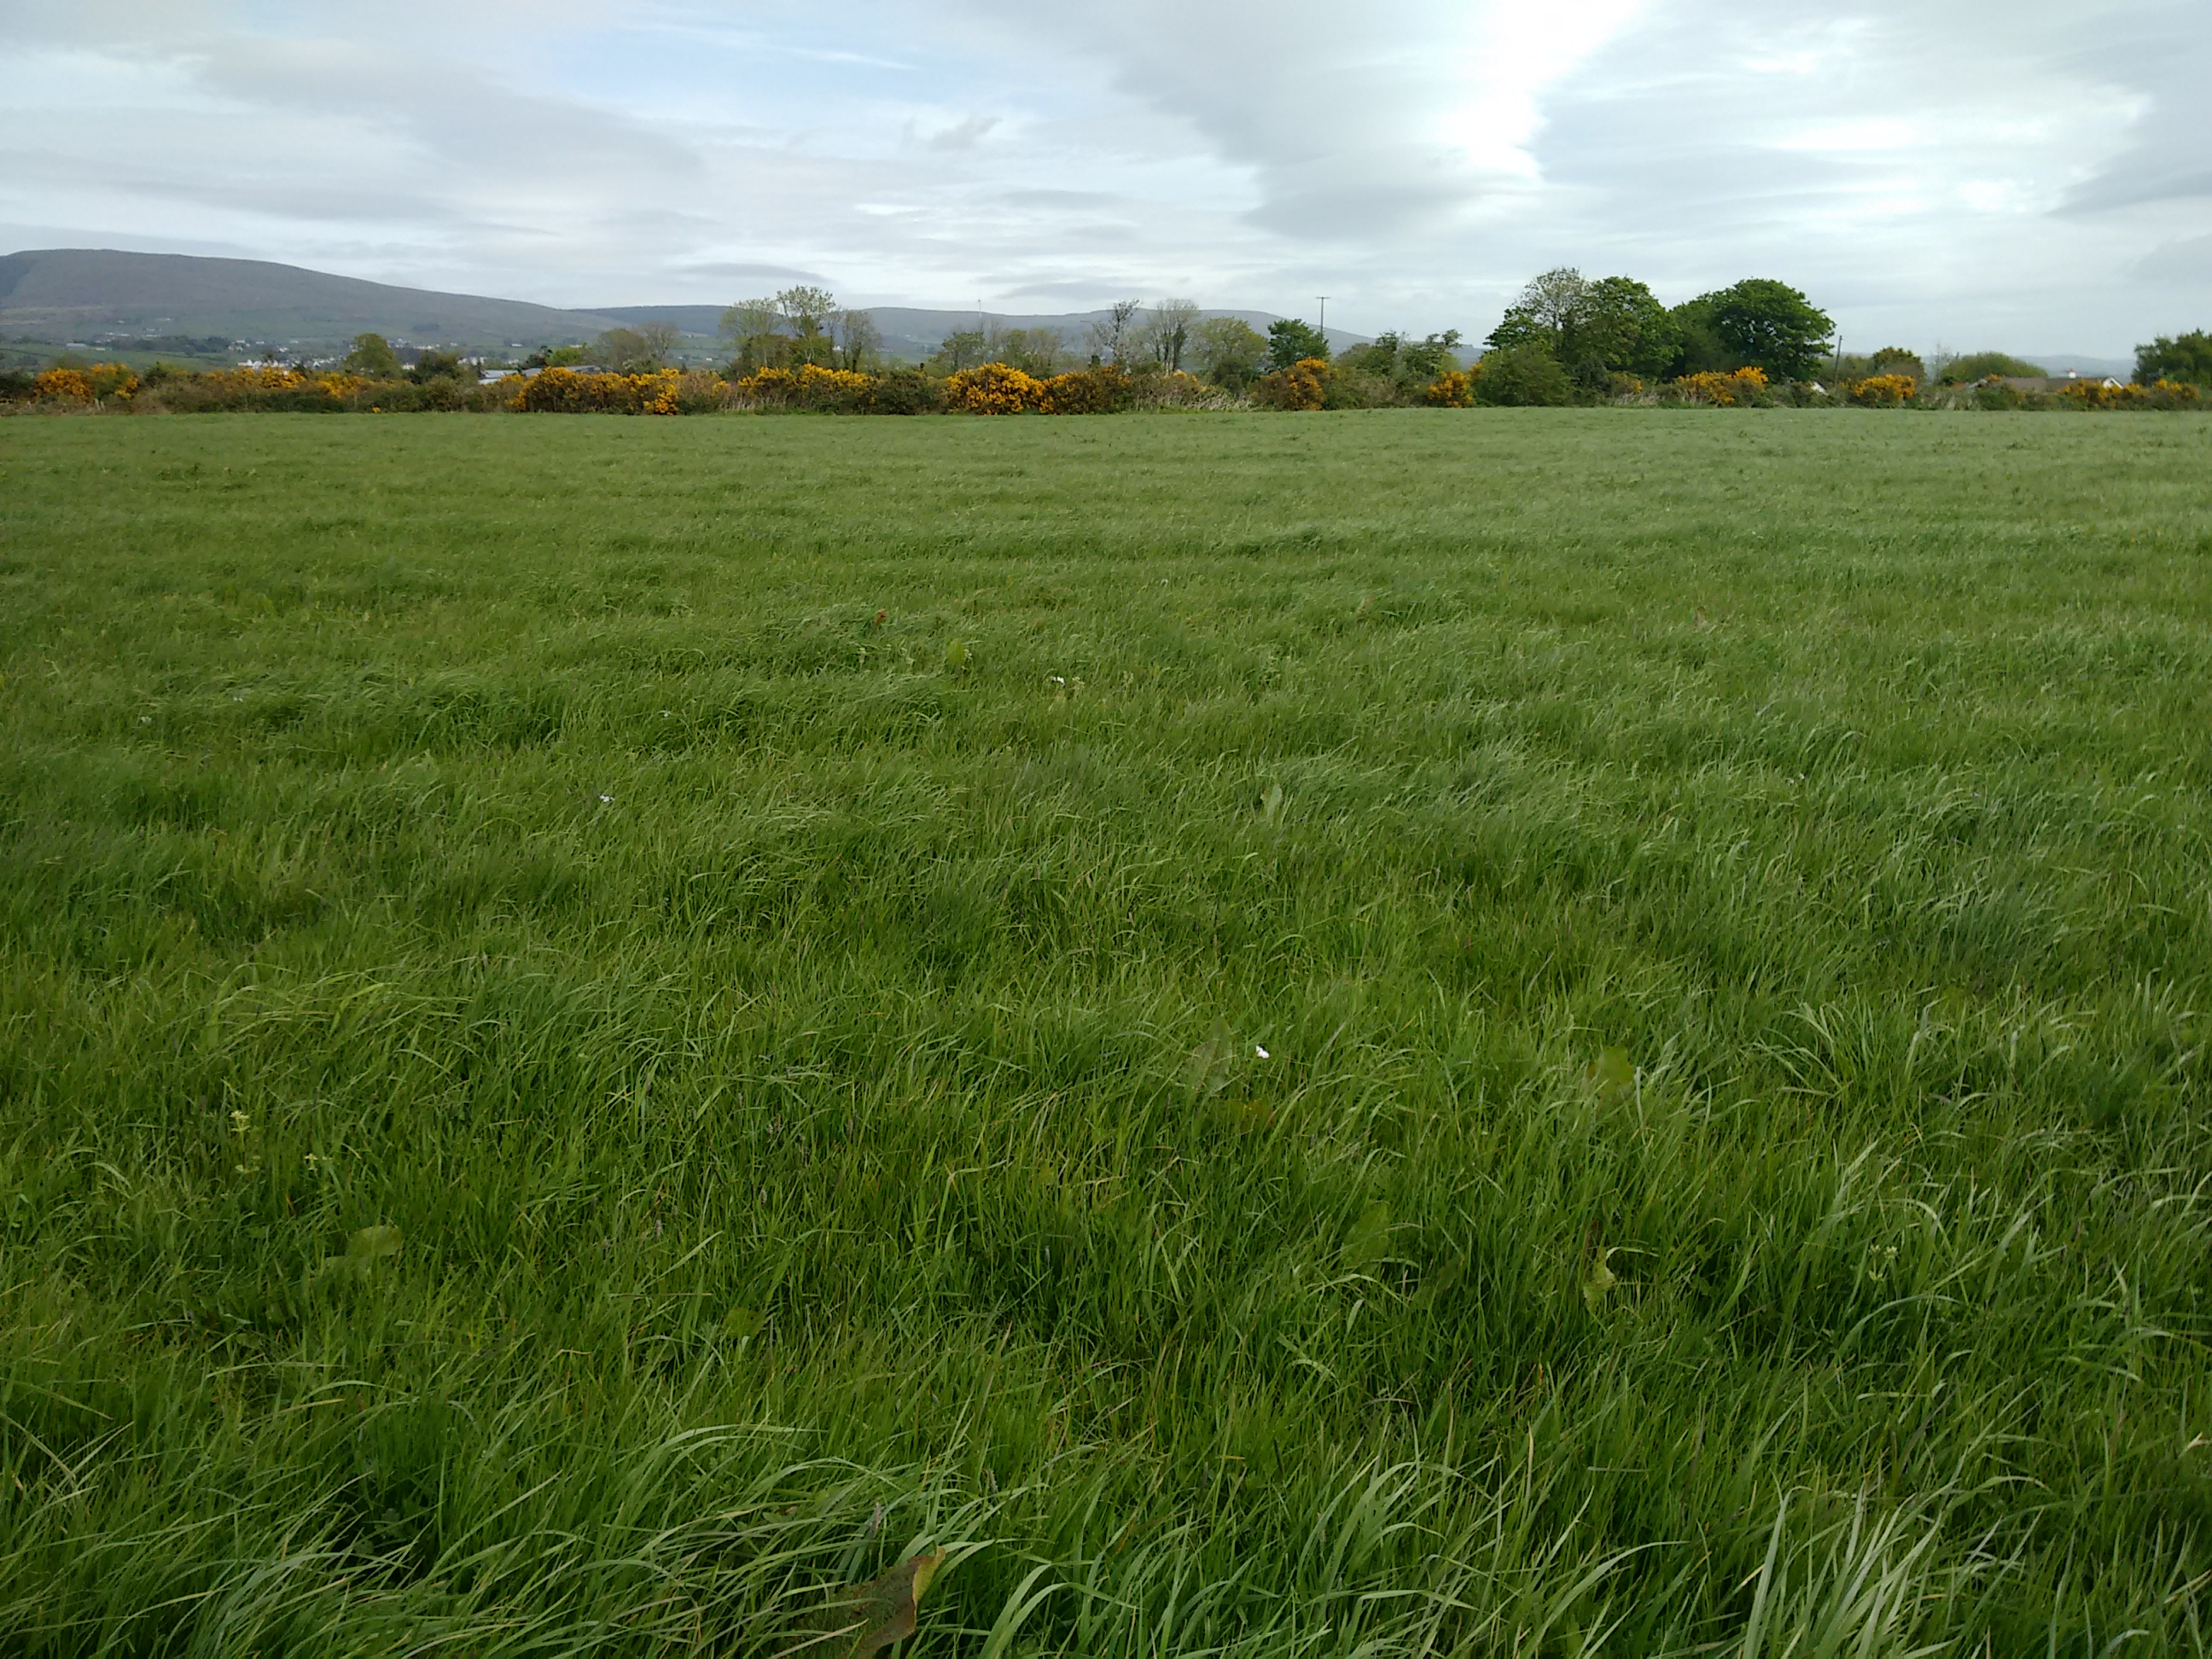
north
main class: Grassland
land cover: Grassland without tree/shrub cover
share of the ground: > 75 %
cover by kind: herbaceous plants 100 %
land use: Agriculture (excluding fallow land and kitchen gardens)
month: May
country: GB
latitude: 55.0598
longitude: -7.2583
